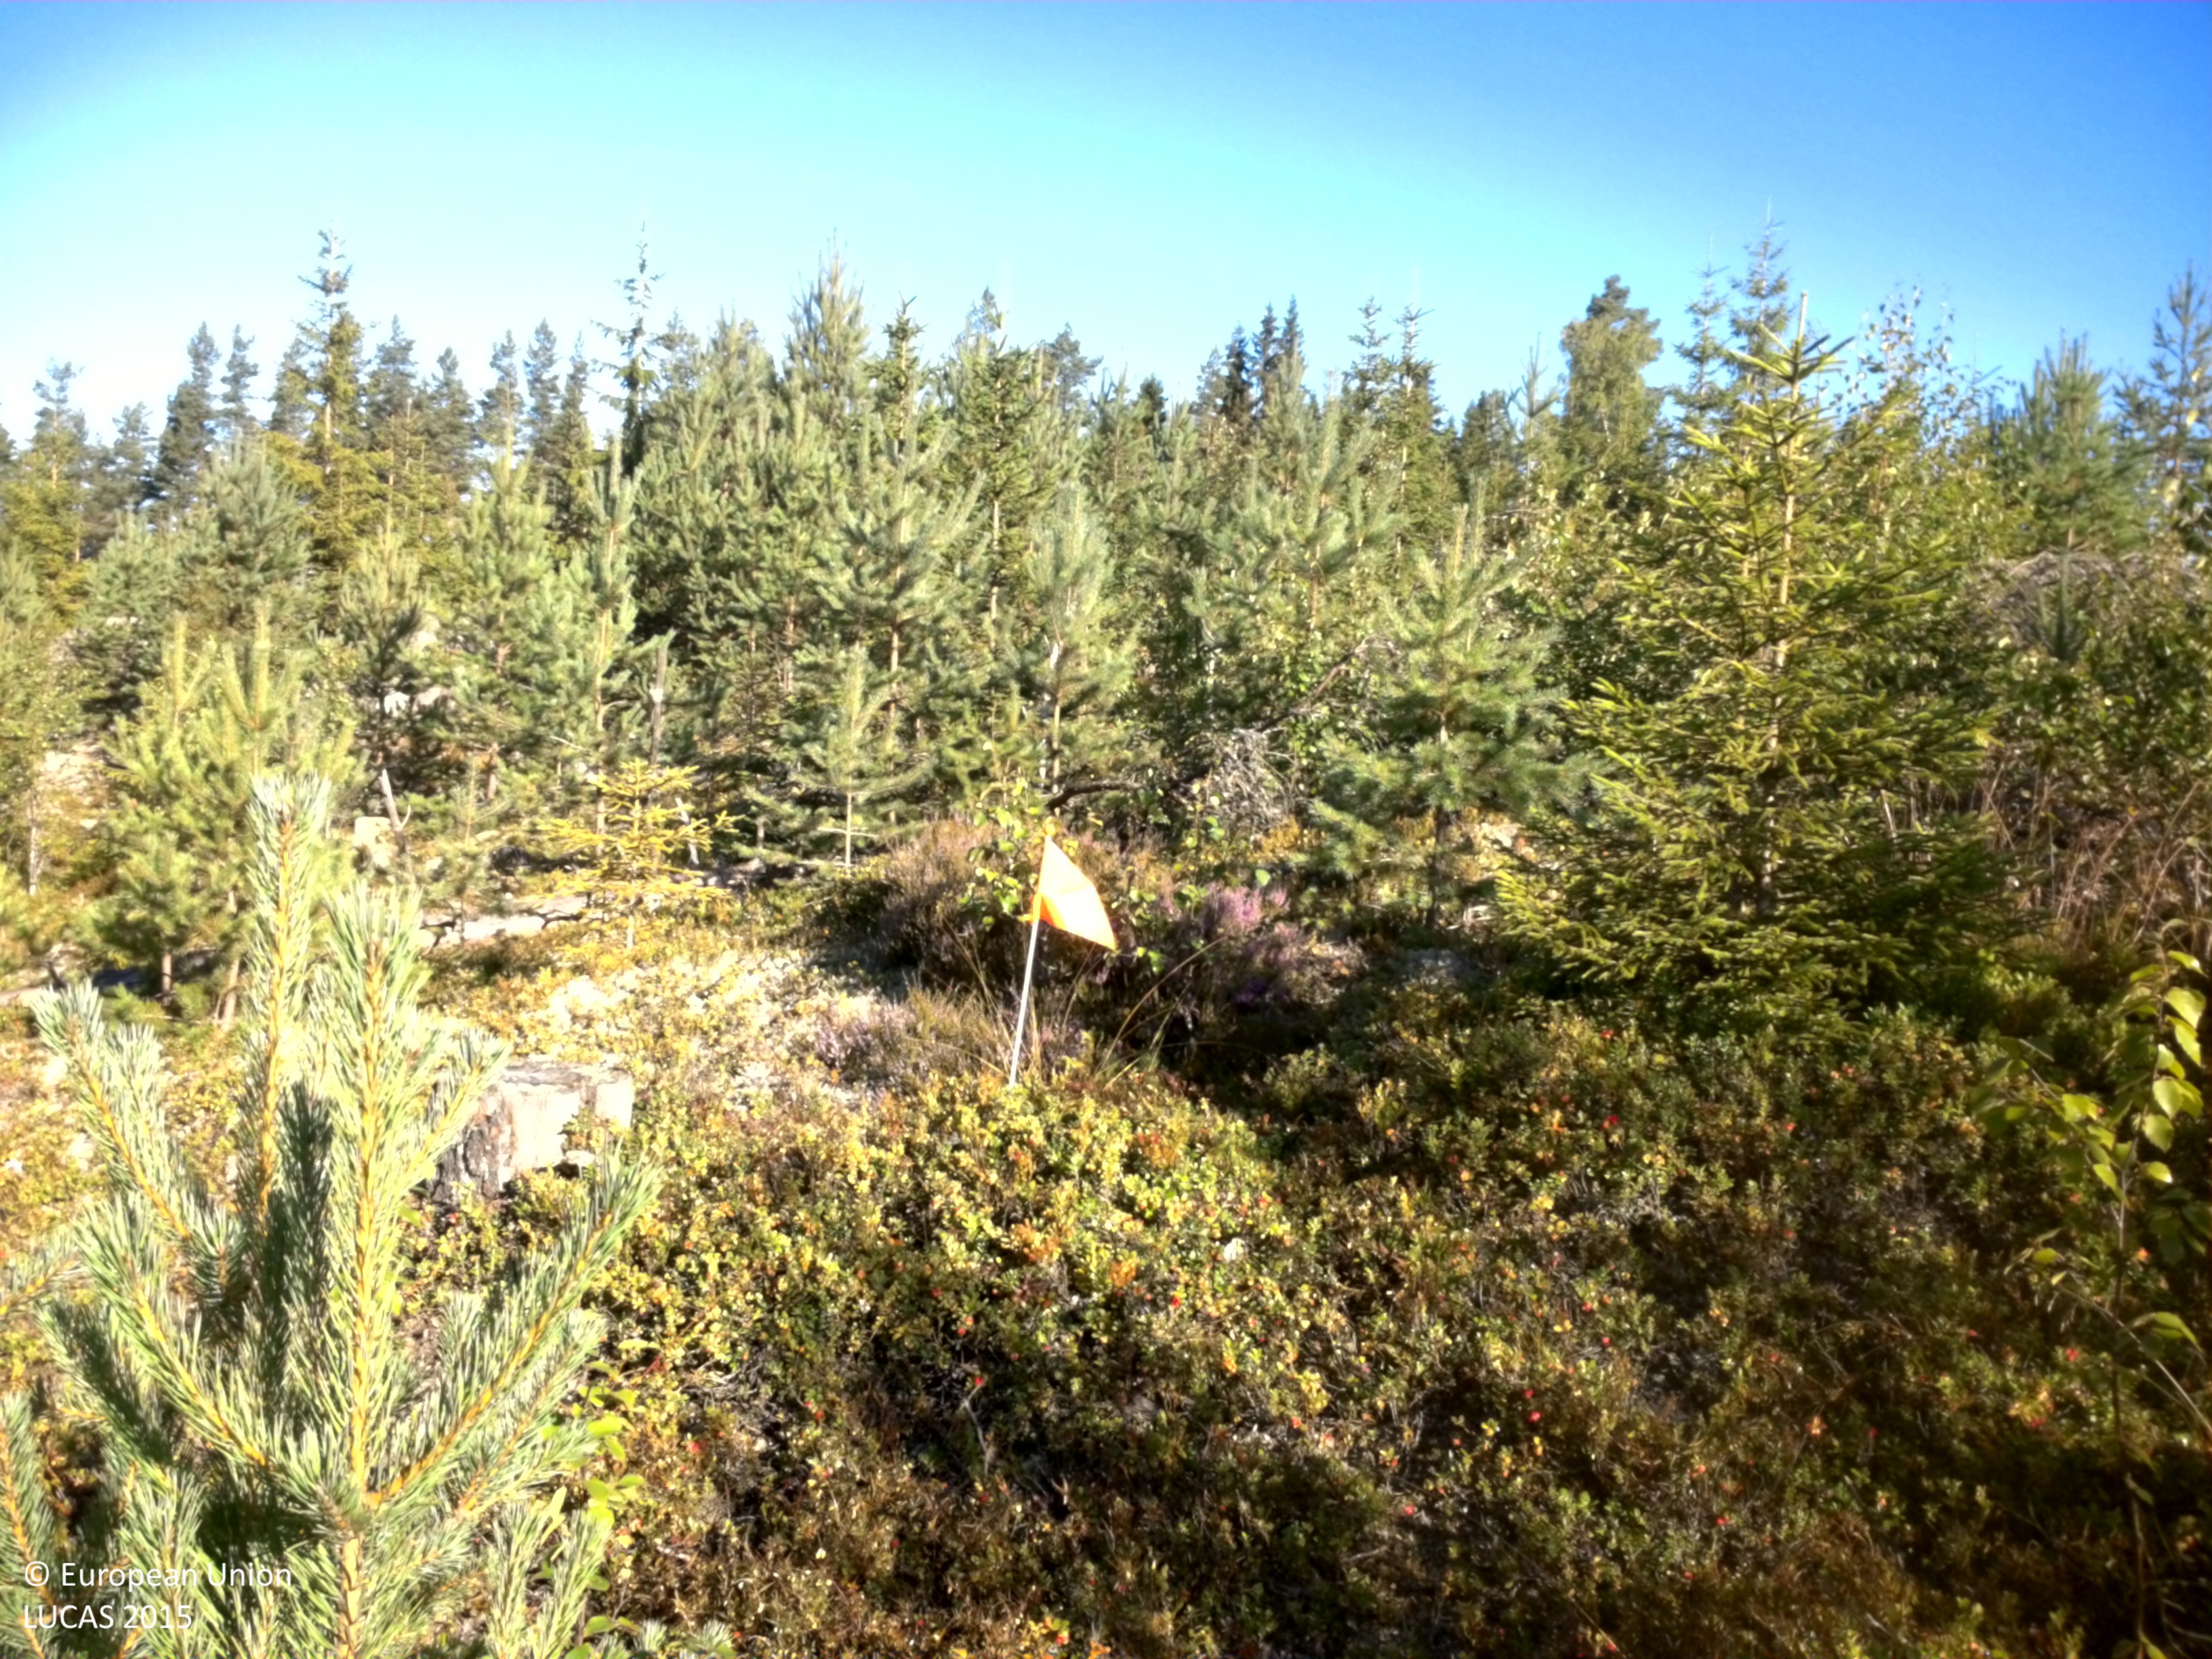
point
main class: Woodland
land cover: Other mixed woodland
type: boreal forest
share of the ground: 50 - 75 %
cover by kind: coniferous forest trees 40 %, broadleaved forest trees 25 %, shrubs 25 %, lichens and mosses 10 %
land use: Forestry
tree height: < 5 m
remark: Clear cut
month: August
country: SE
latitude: 60.0310
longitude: 14.0998
